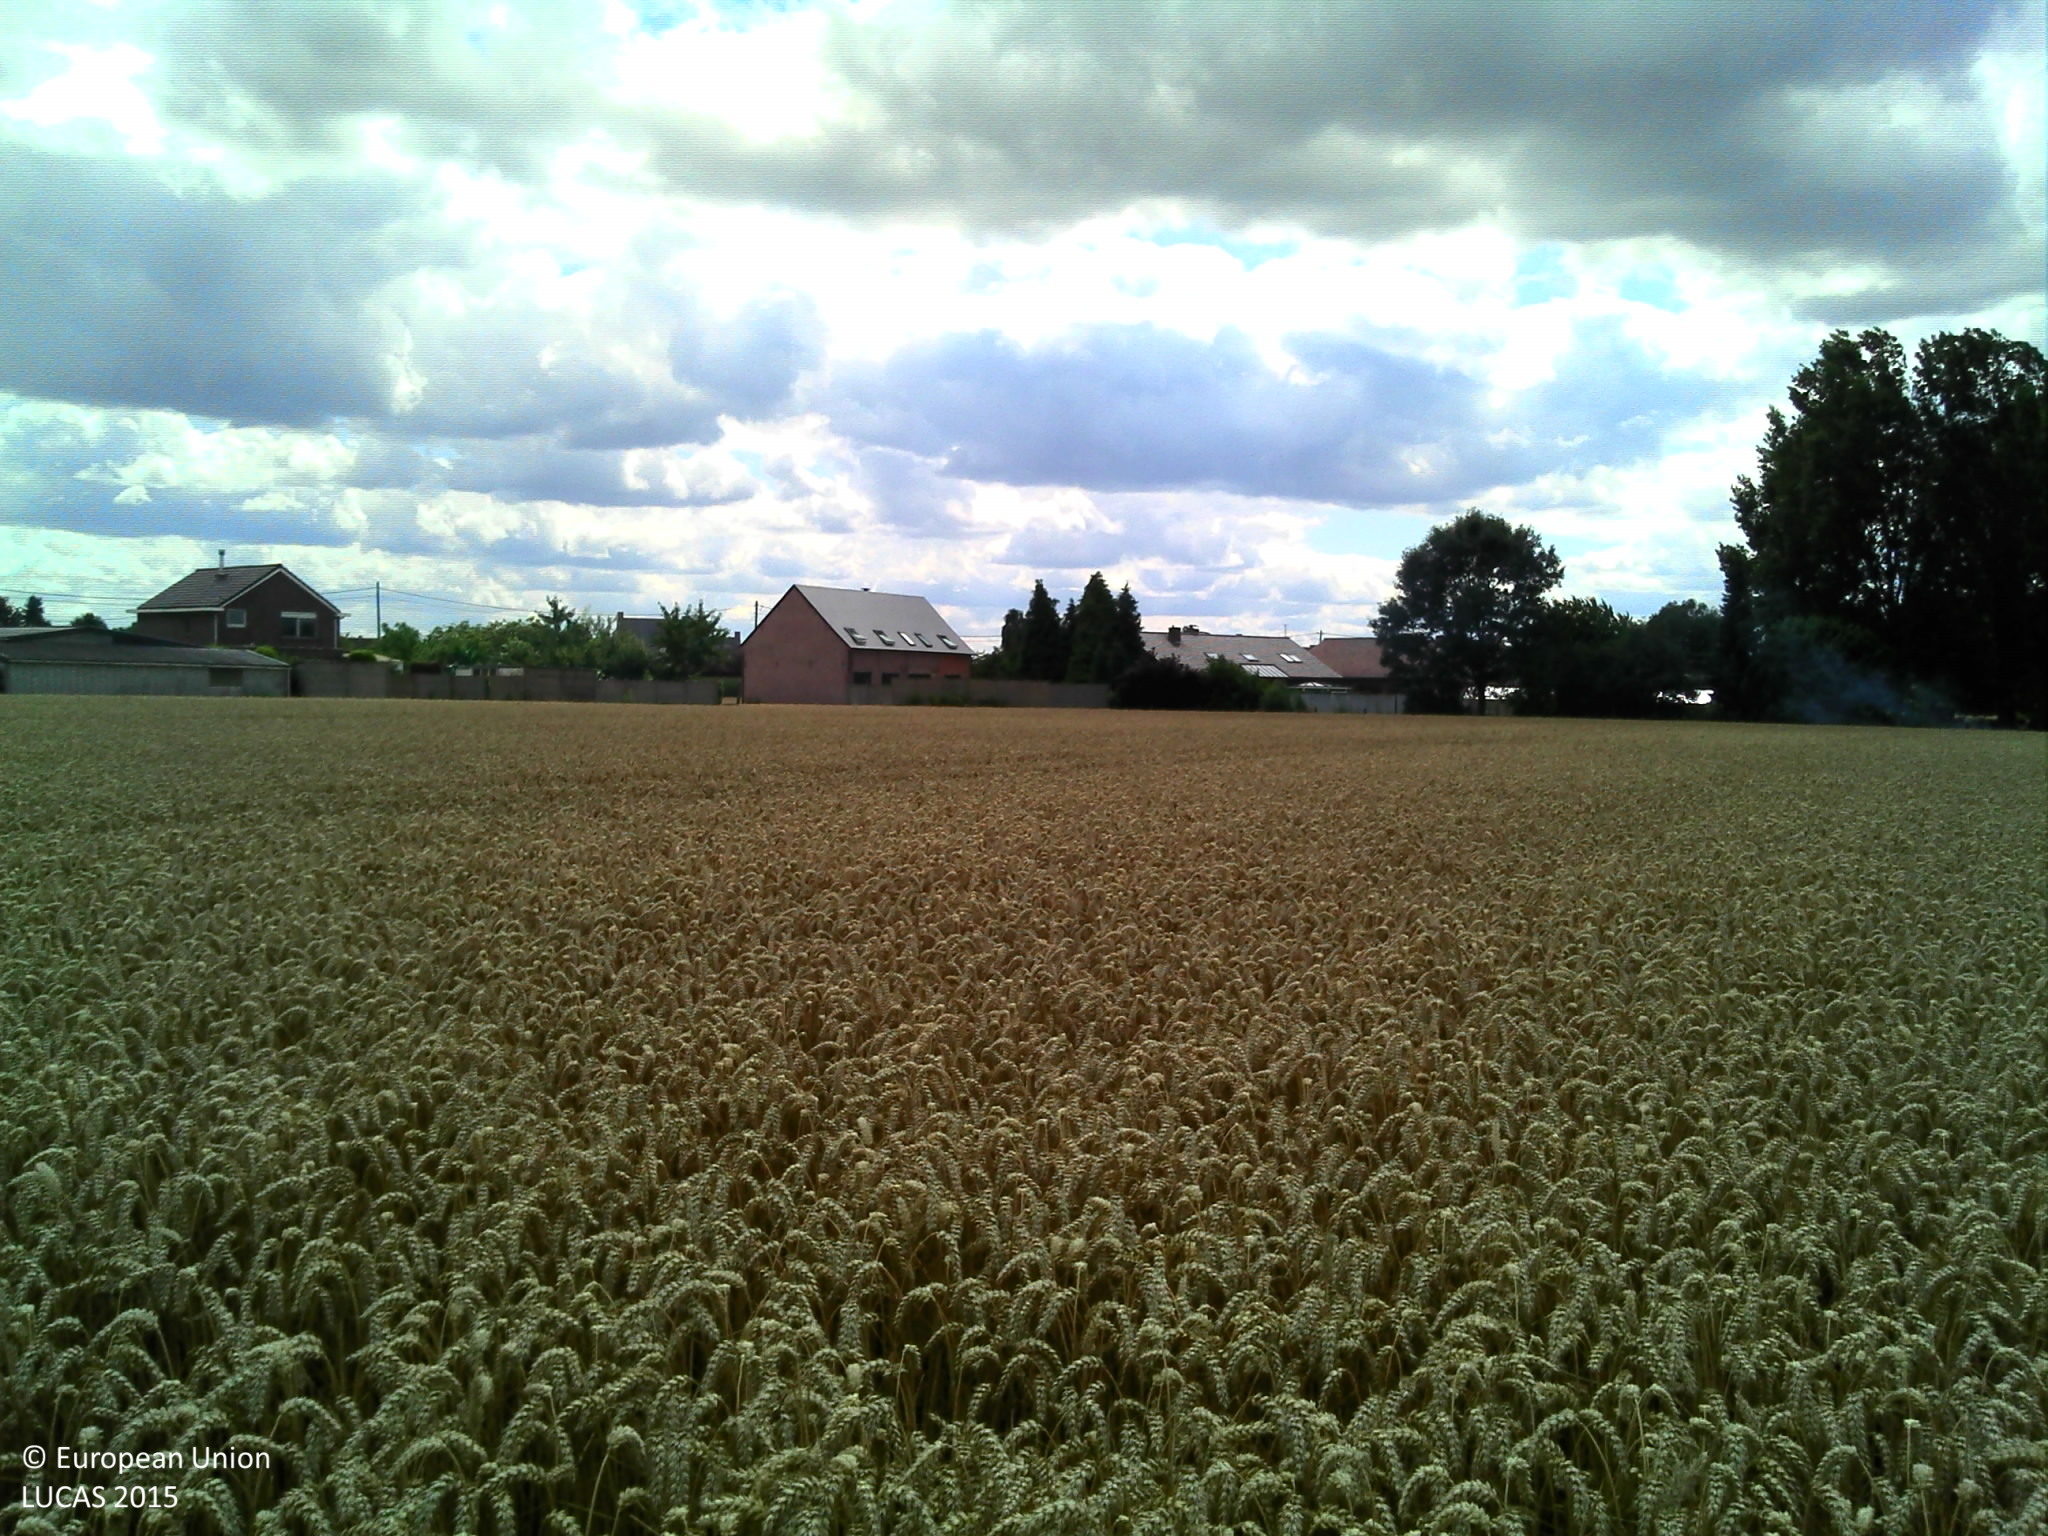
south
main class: Cropland
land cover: Common wheat
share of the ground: > 75 %
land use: Agriculture (excluding fallow land and kitchen gardens)
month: July
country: BE
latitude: 51.0210
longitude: 4.4214
